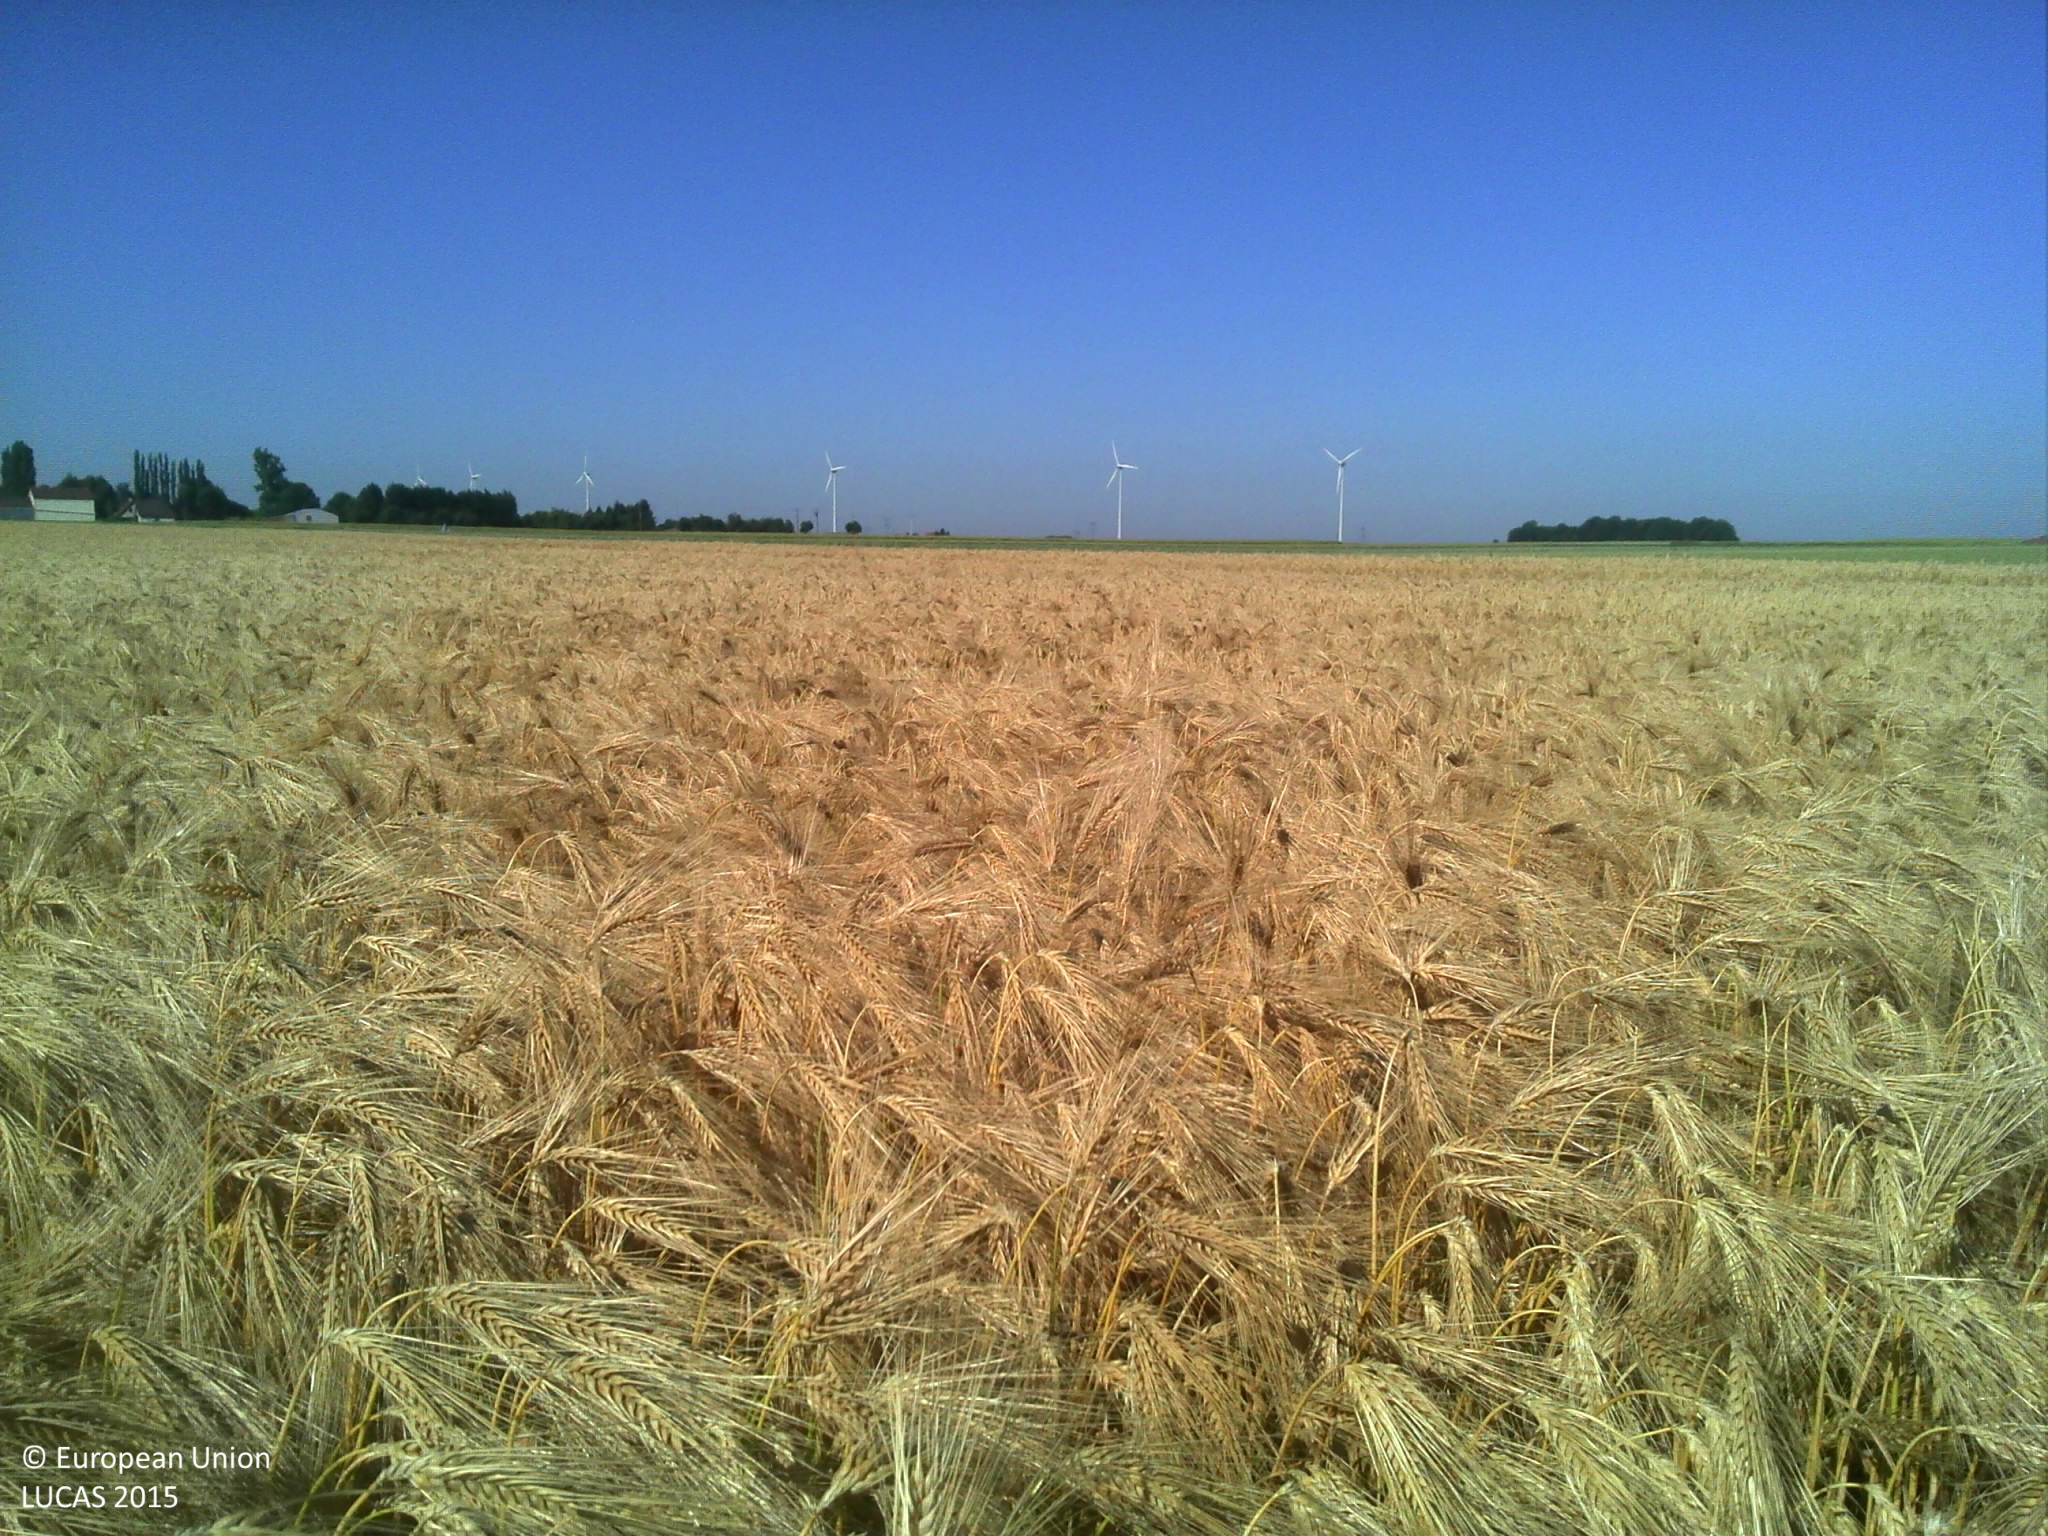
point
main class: Cropland
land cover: Barley
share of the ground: > 75 %
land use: Agriculture (excluding fallow land and kitchen gardens)
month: June
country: FR
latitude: 49.7777
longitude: 2.2792
